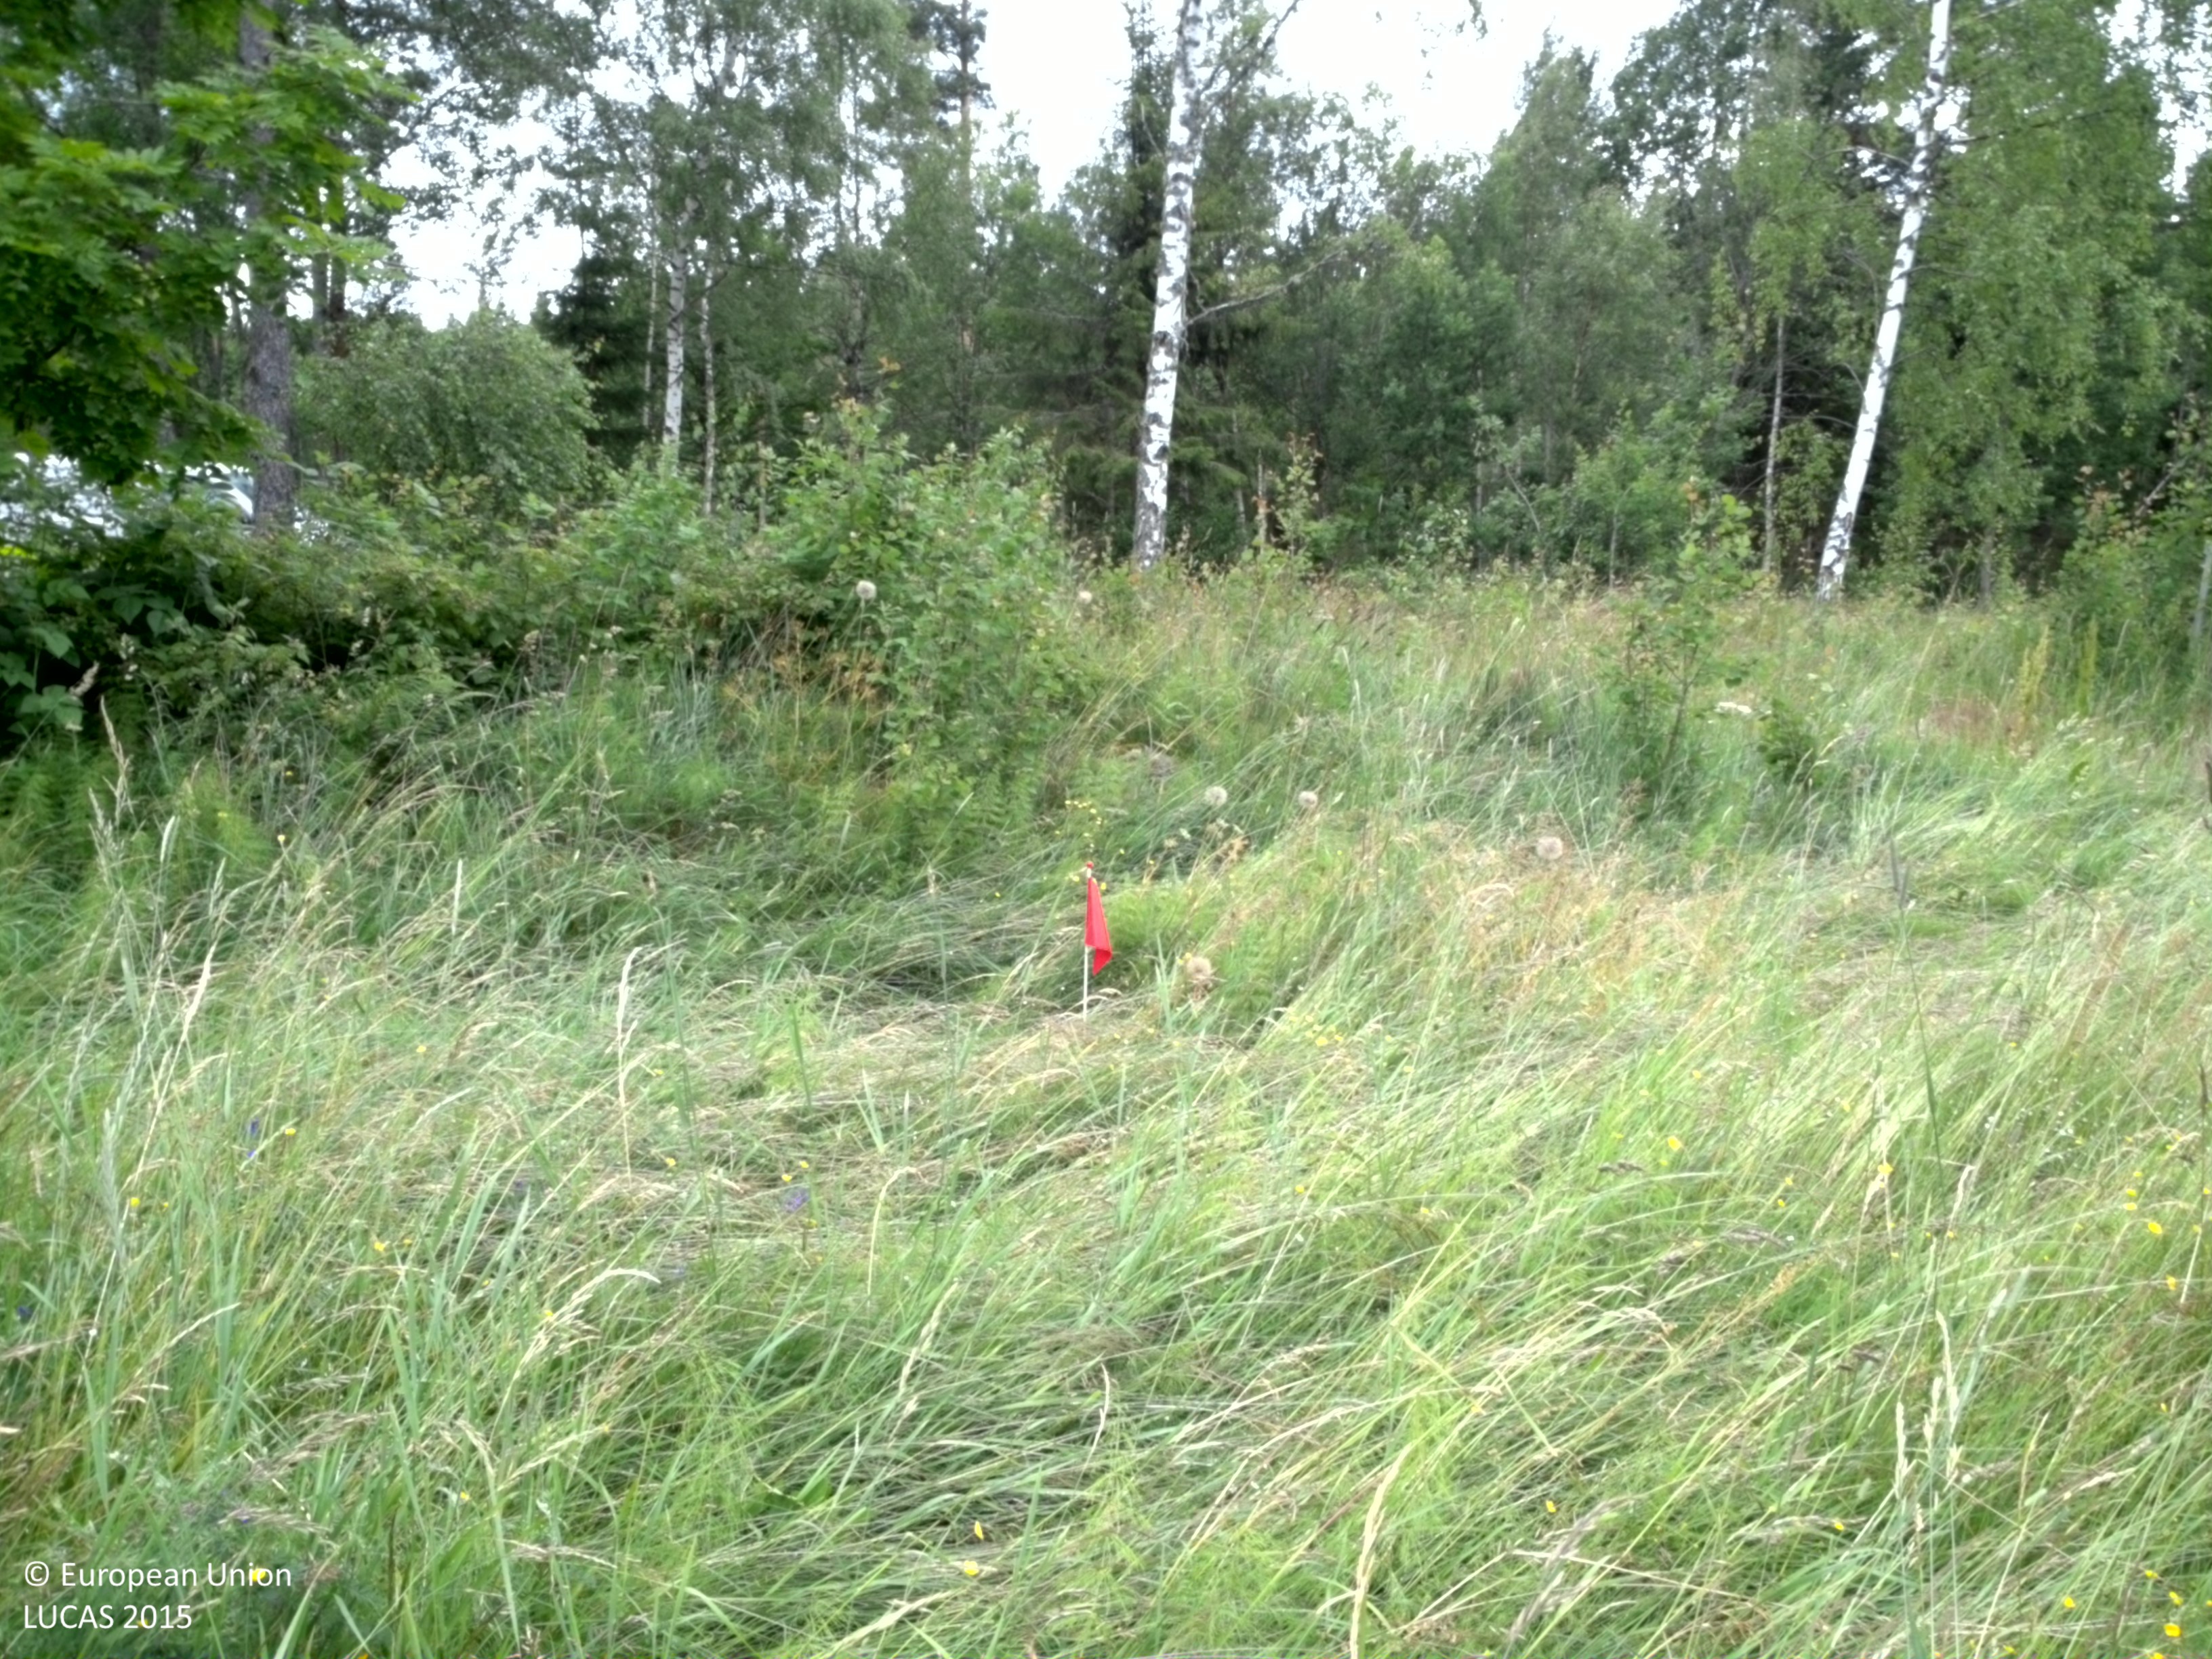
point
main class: Grassland
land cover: Grassland without tree/shrub cover
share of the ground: > 75 %
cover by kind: herbaceous plants 100 %
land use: Agriculture (excluding fallow land and kitchen gardens)
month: July
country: SE
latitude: 58.1424
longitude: 13.9862
